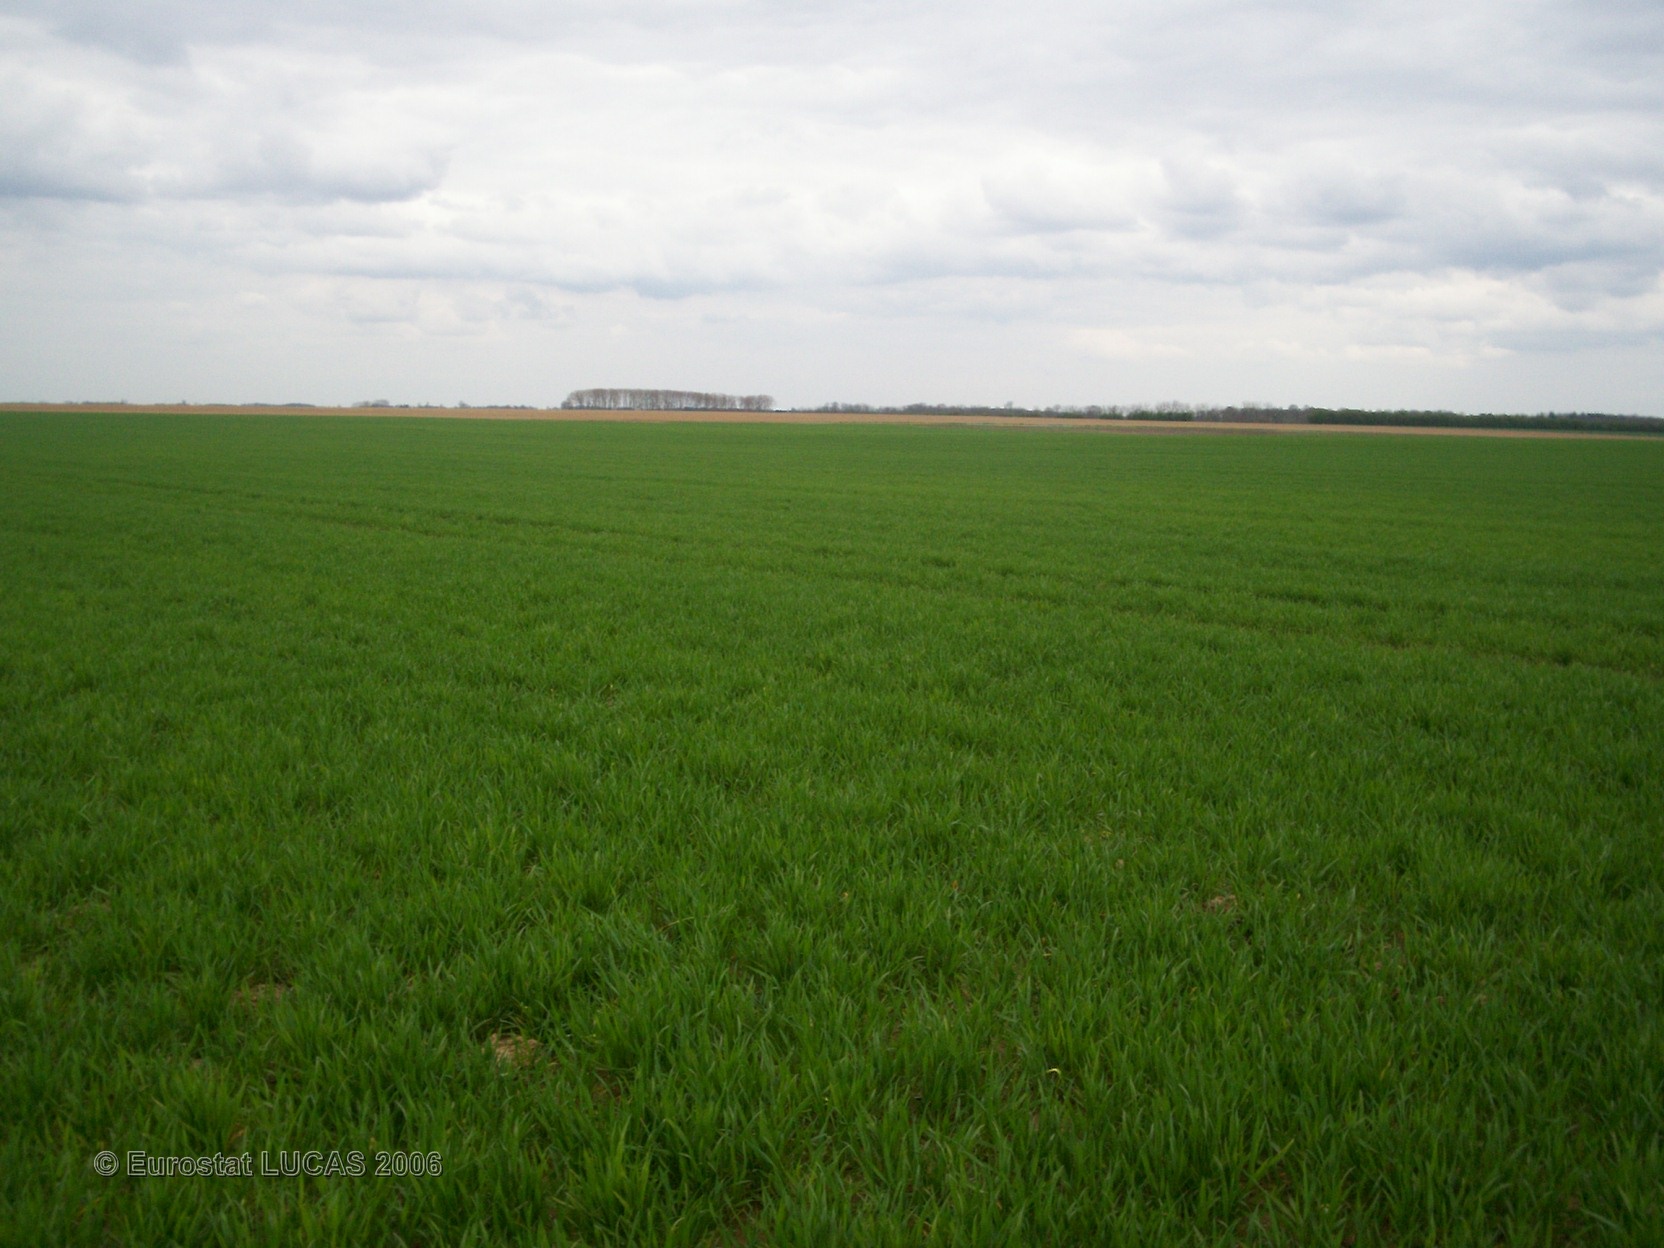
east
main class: Cropland
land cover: Common wheat
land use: Agriculture (excluding fallow land and kitchen gardens)
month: April
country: FR
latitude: 49.1578
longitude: 0.9965
